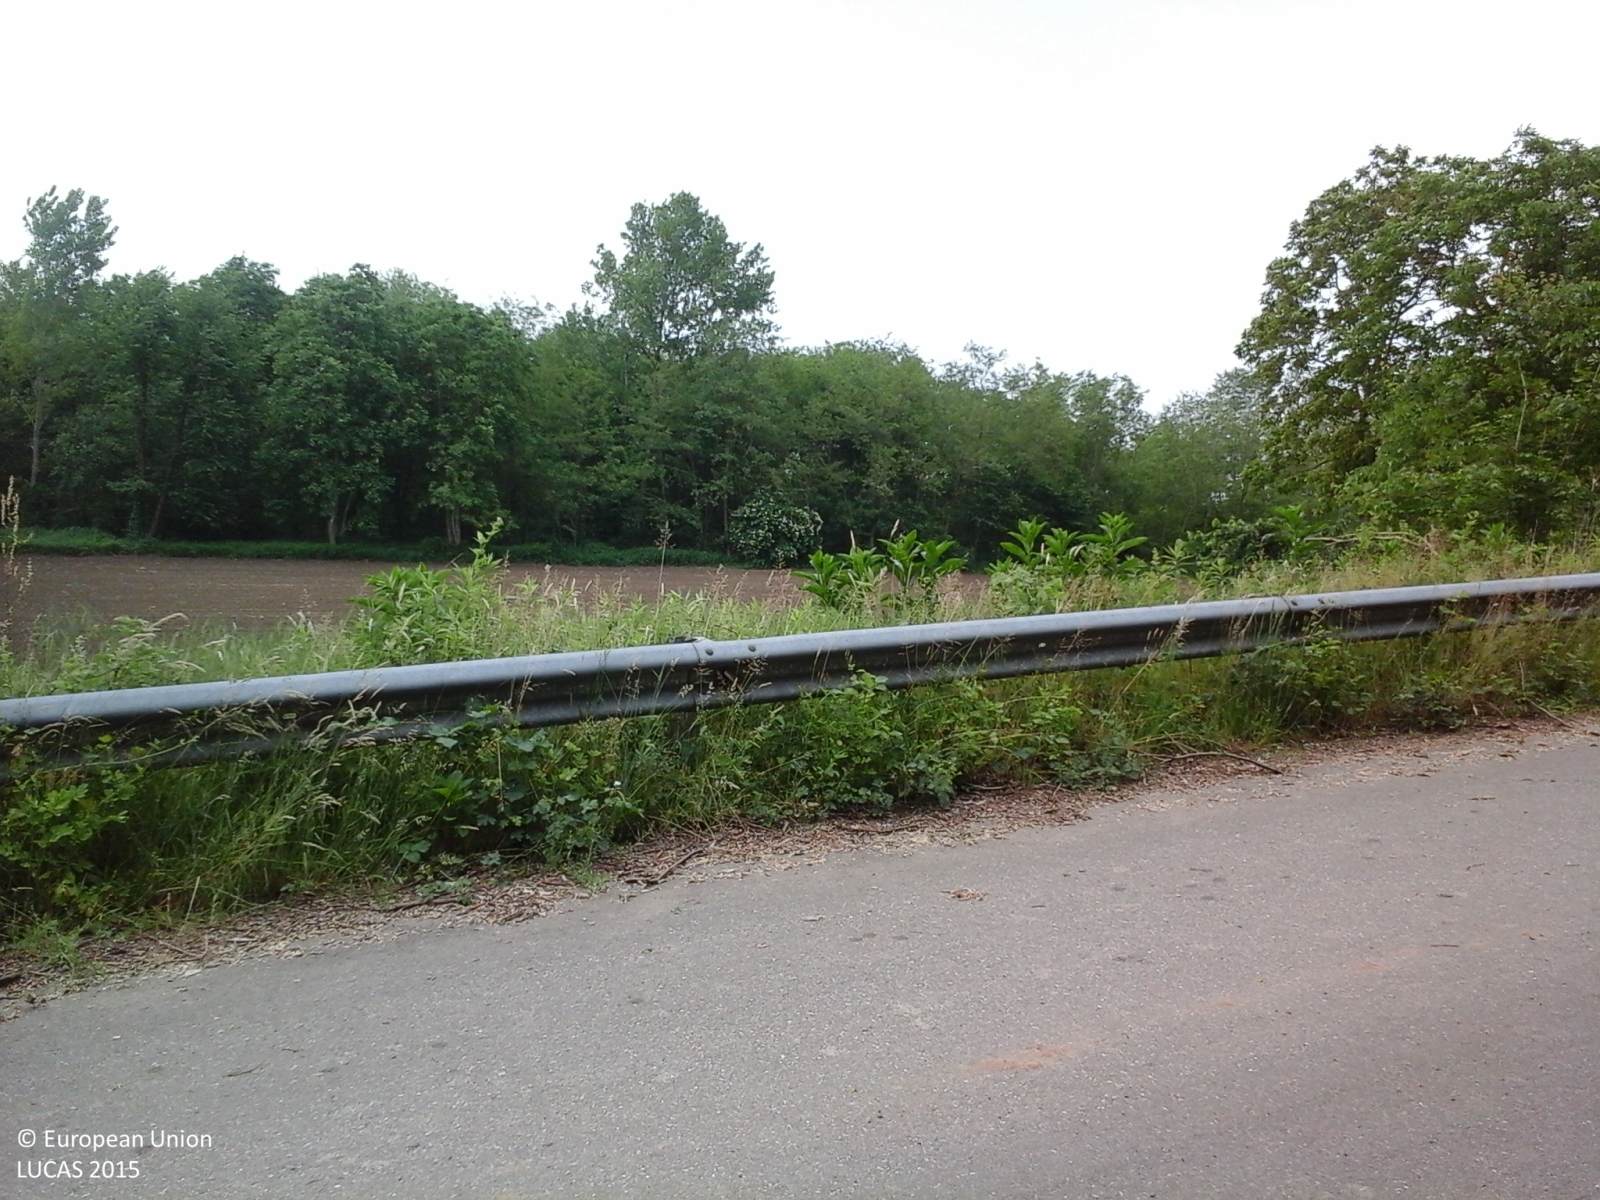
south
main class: Woodland
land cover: Broadleaved woodland
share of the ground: > 75 %
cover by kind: broadleaved forest trees 100 %
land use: Forestry
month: May
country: IT
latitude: 45.5468
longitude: 8.4271
